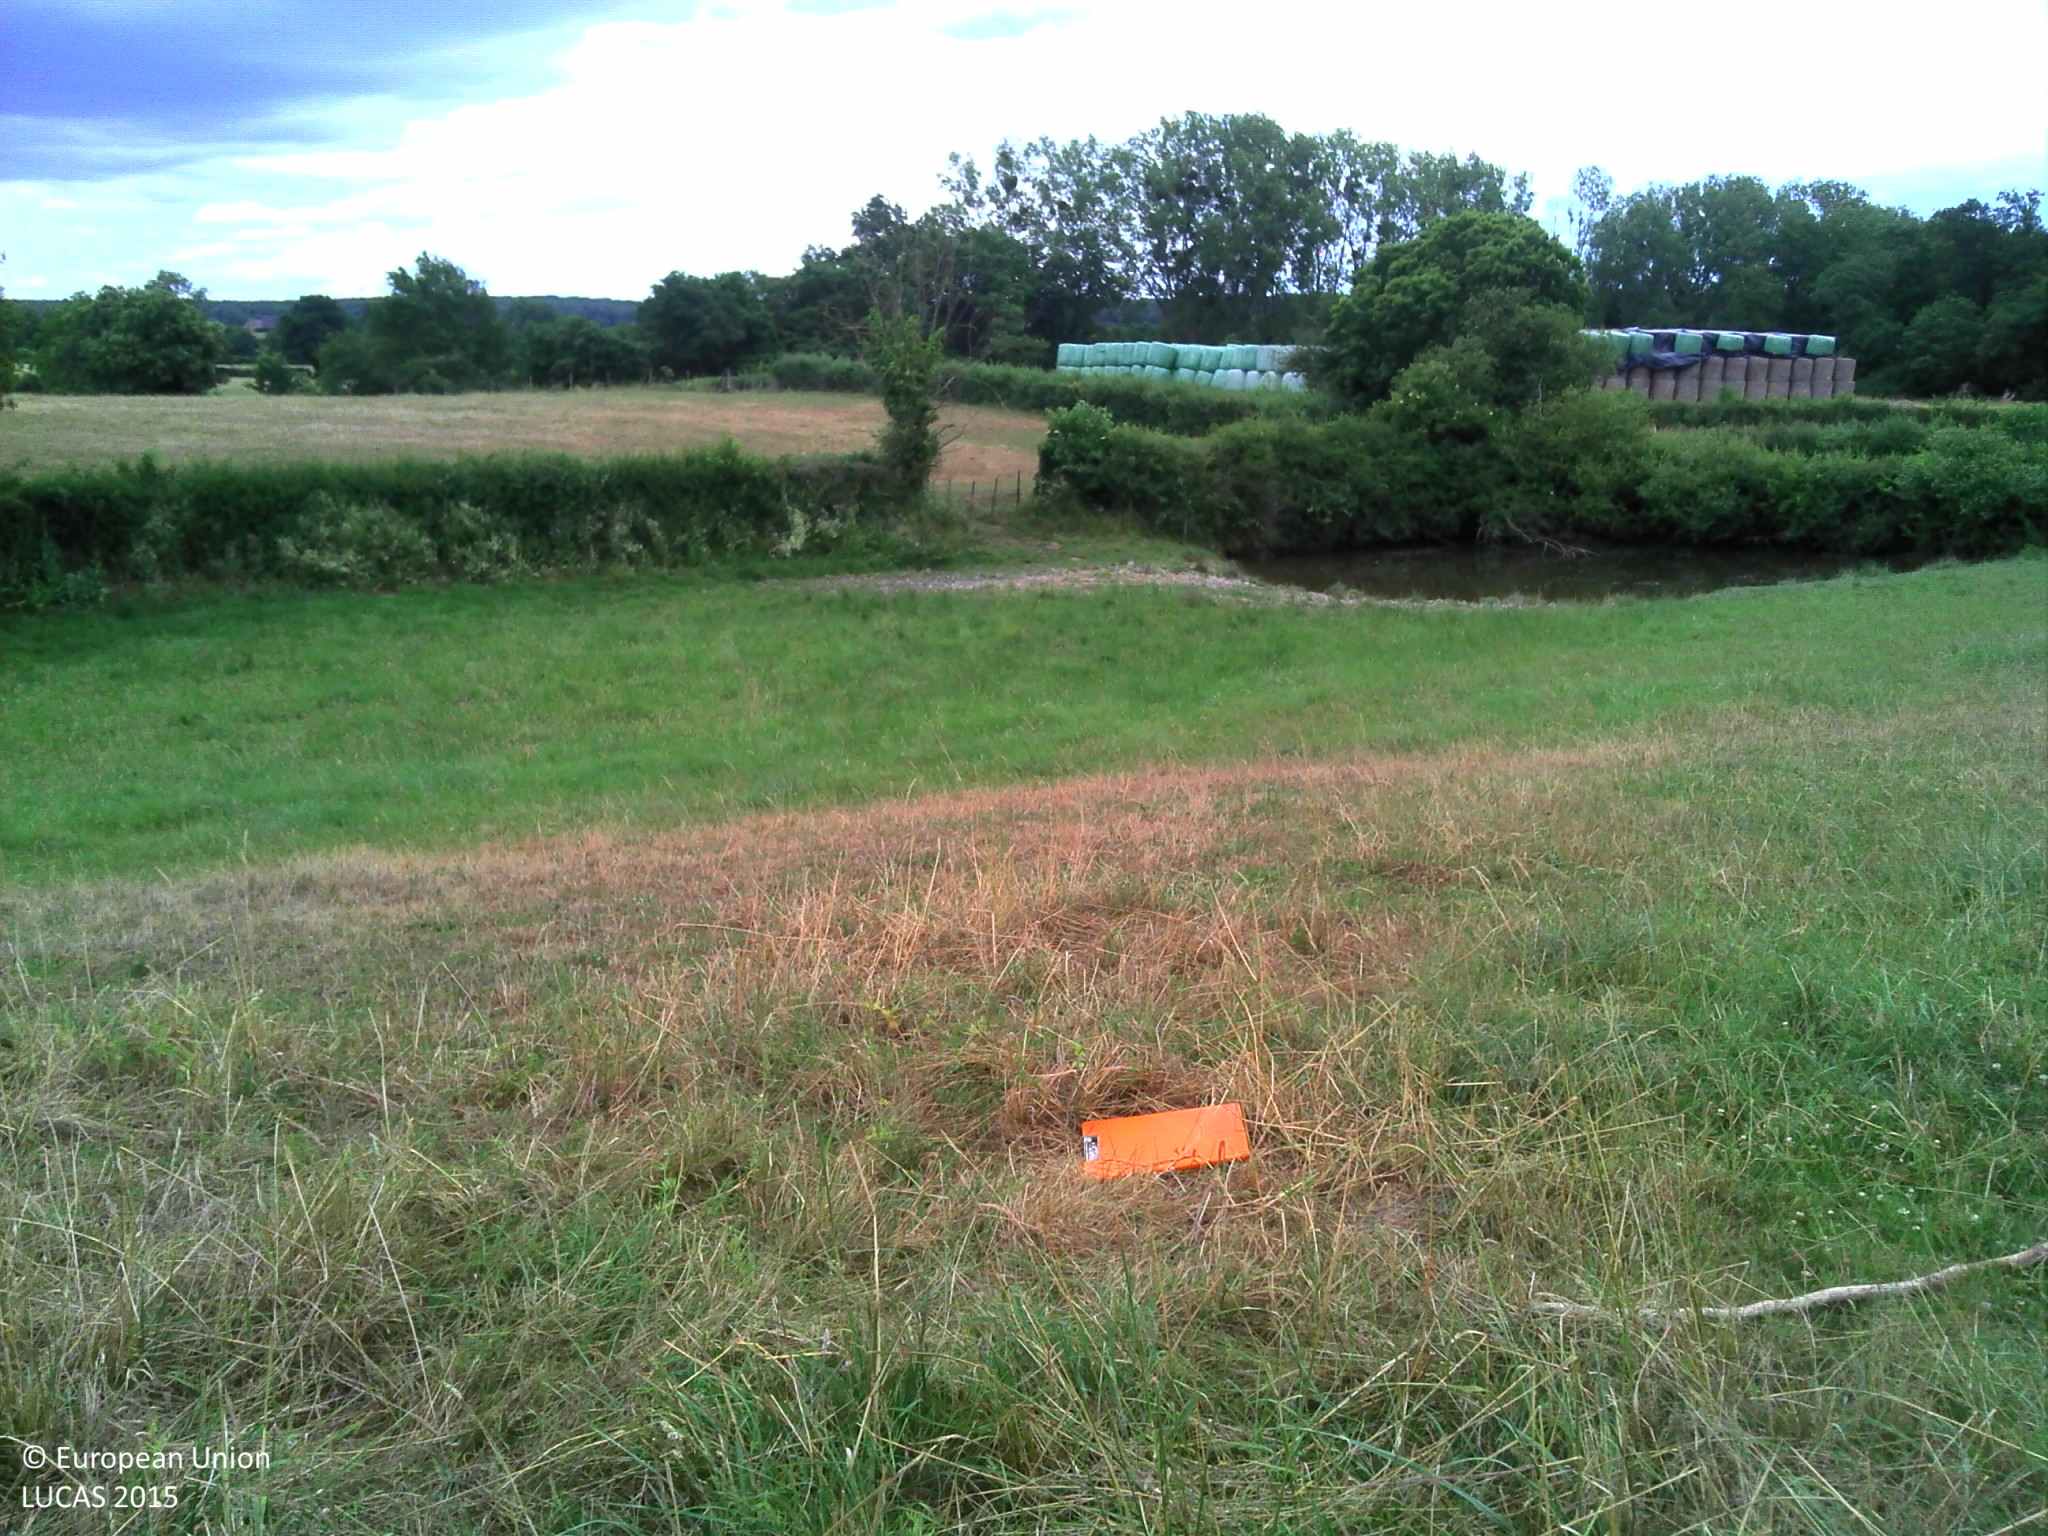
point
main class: Grassland
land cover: Grassland without tree/shrub cover
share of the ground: > 75 %
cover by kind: herbaceous plants 100 %
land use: Agriculture (excluding fallow land and kitchen gardens)
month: June
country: FR
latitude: 46.5199
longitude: 2.7355
